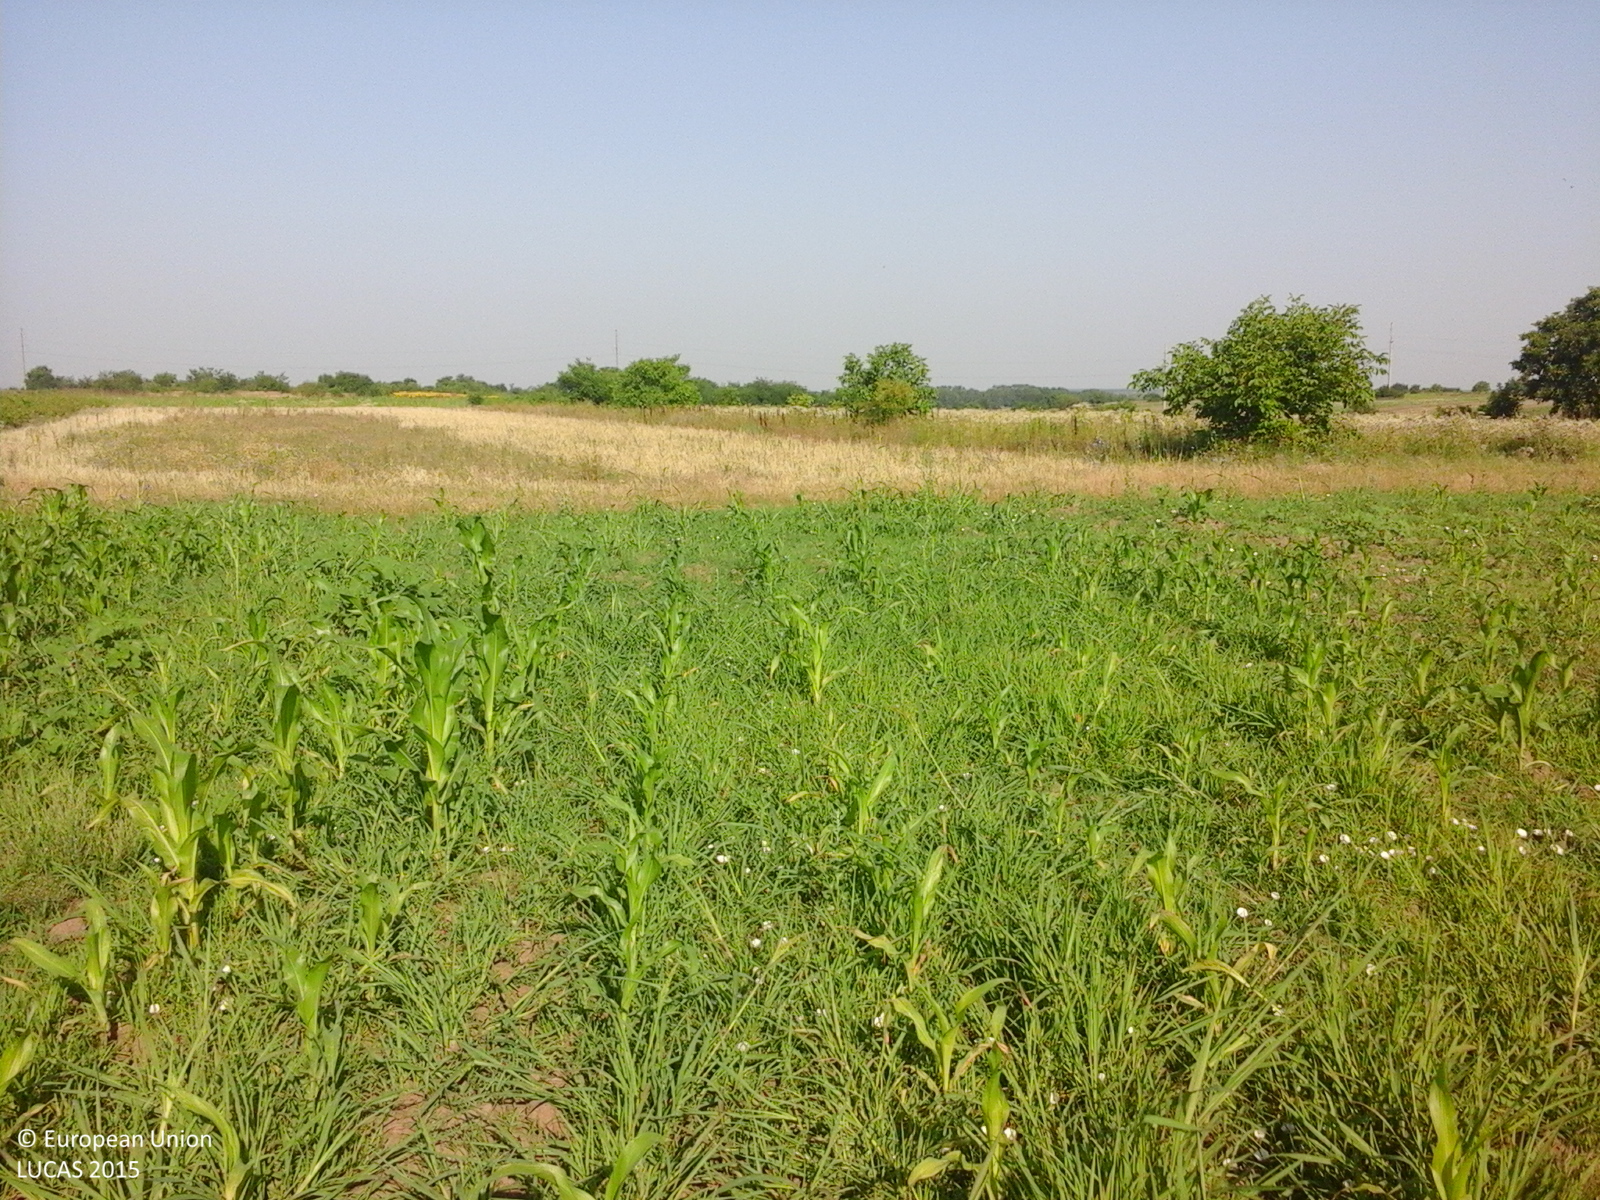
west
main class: Cropland
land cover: Maize
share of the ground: 25 - 50 %
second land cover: Spontaneously vegetated surfaces
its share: 50 - 75 %
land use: Agriculture (excluding fallow land and kitchen gardens)
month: July
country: RO
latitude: 44.1182
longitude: 25.3419
